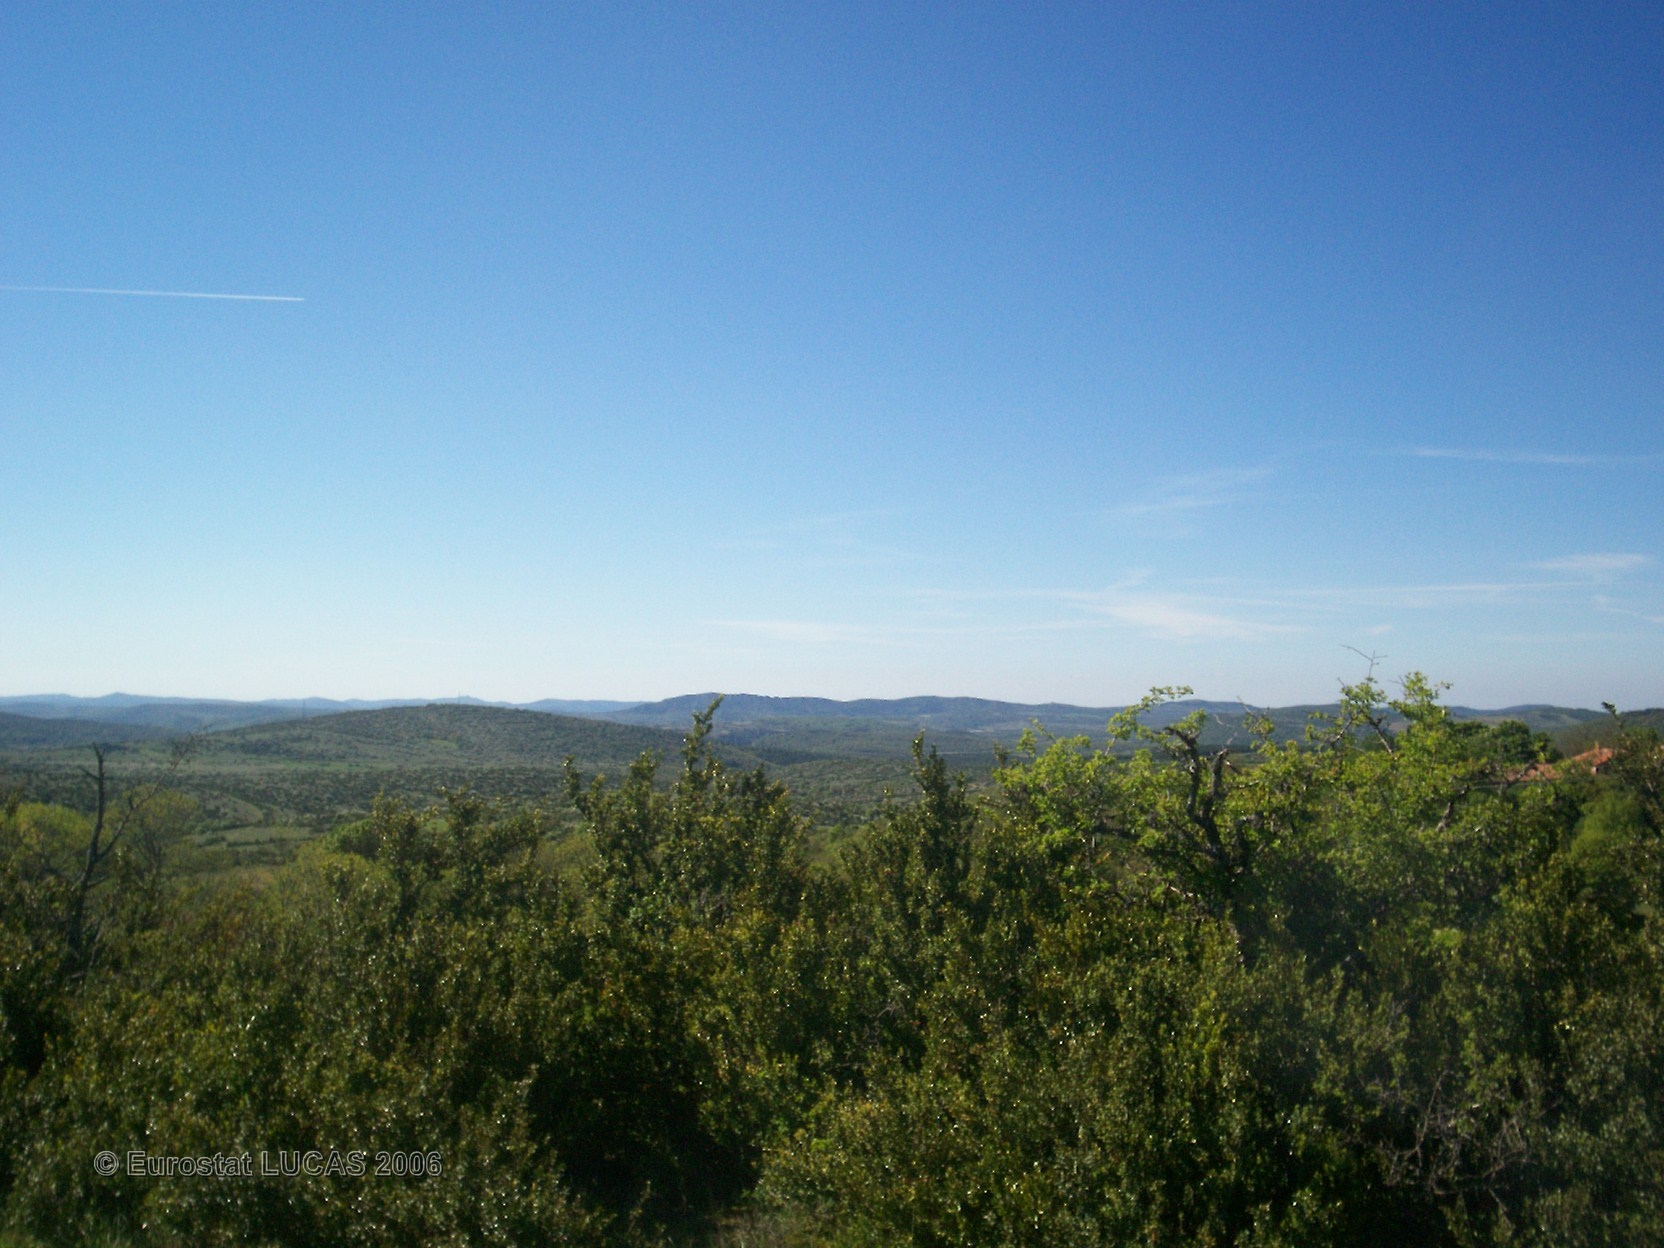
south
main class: Grassland
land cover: Grassland with sparse tree/shrub cover
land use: Agriculture (excluding fallow land and kitchen gardens)
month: May
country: FR
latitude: 43.9588
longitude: 3.3897
